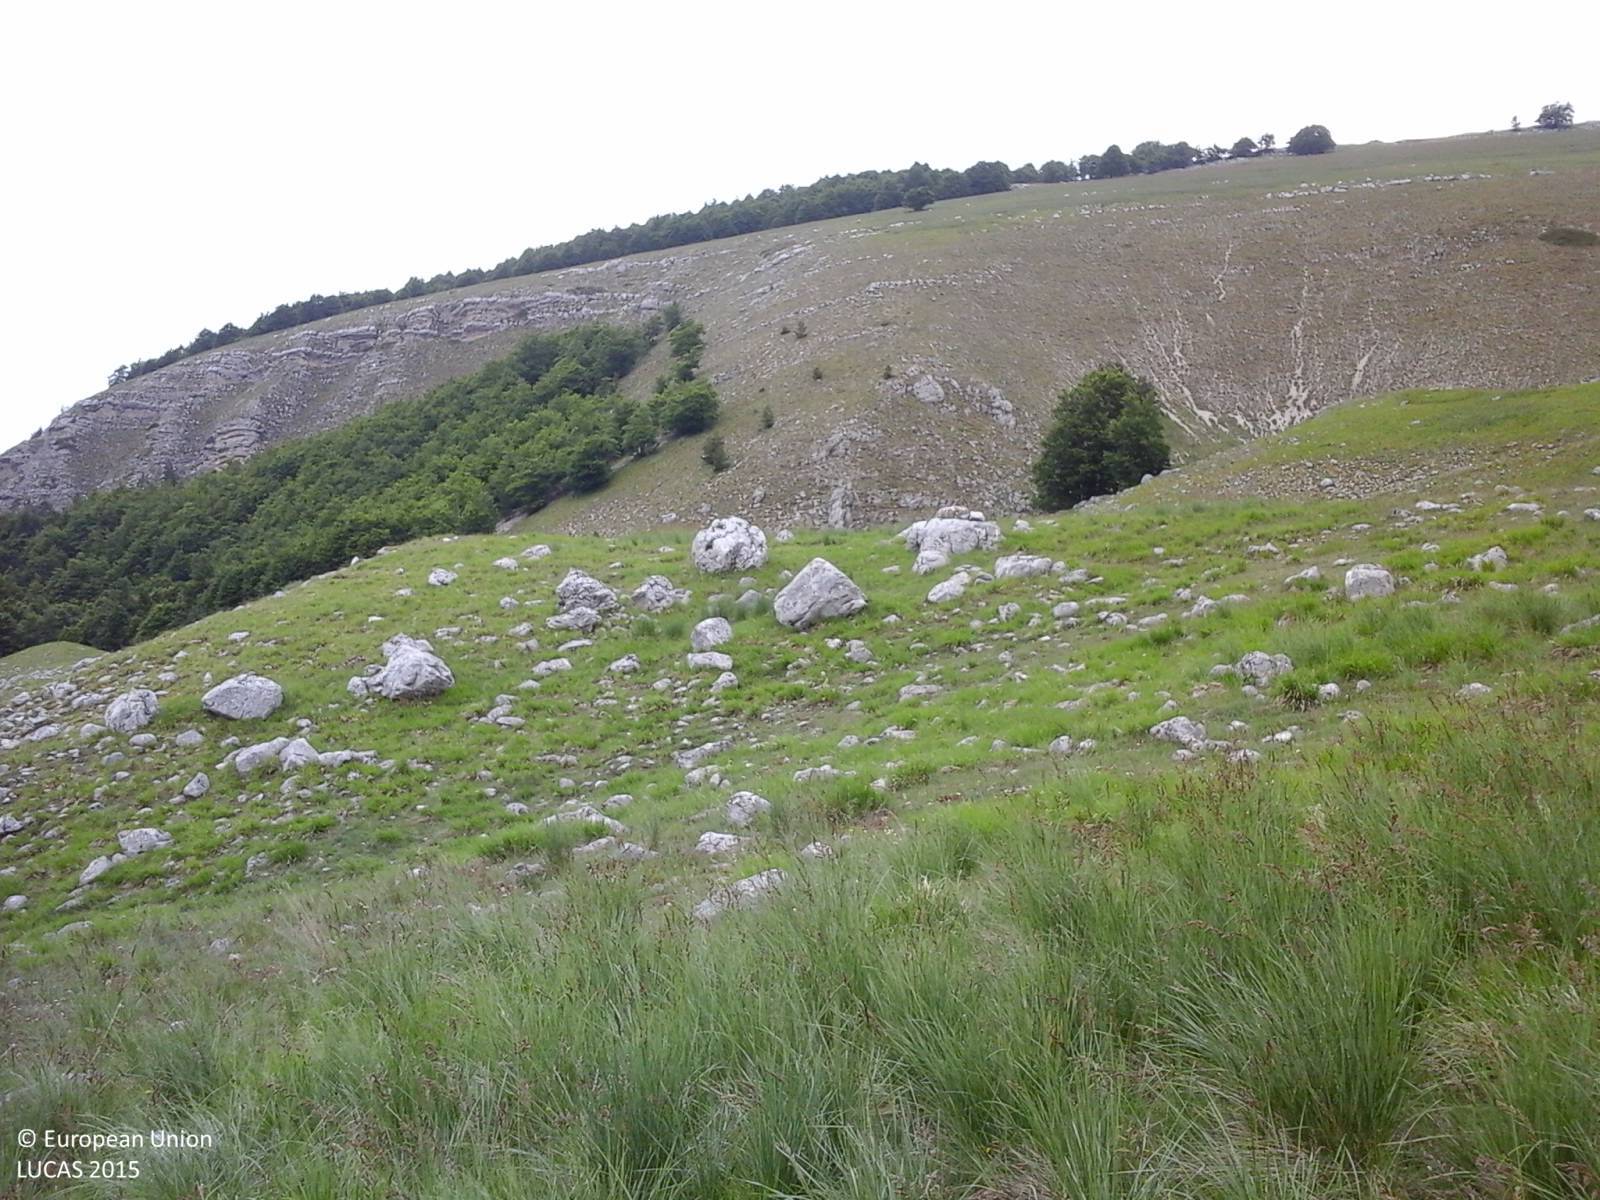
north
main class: Grassland
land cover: Grassland without tree/shrub cover
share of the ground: > 75 %
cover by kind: herbaceous plants 95 %, unconsolidated bare surface 5 %
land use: Agriculture (excluding fallow land and kitchen gardens)
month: June
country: IT
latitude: 41.8526
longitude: 13.9732
